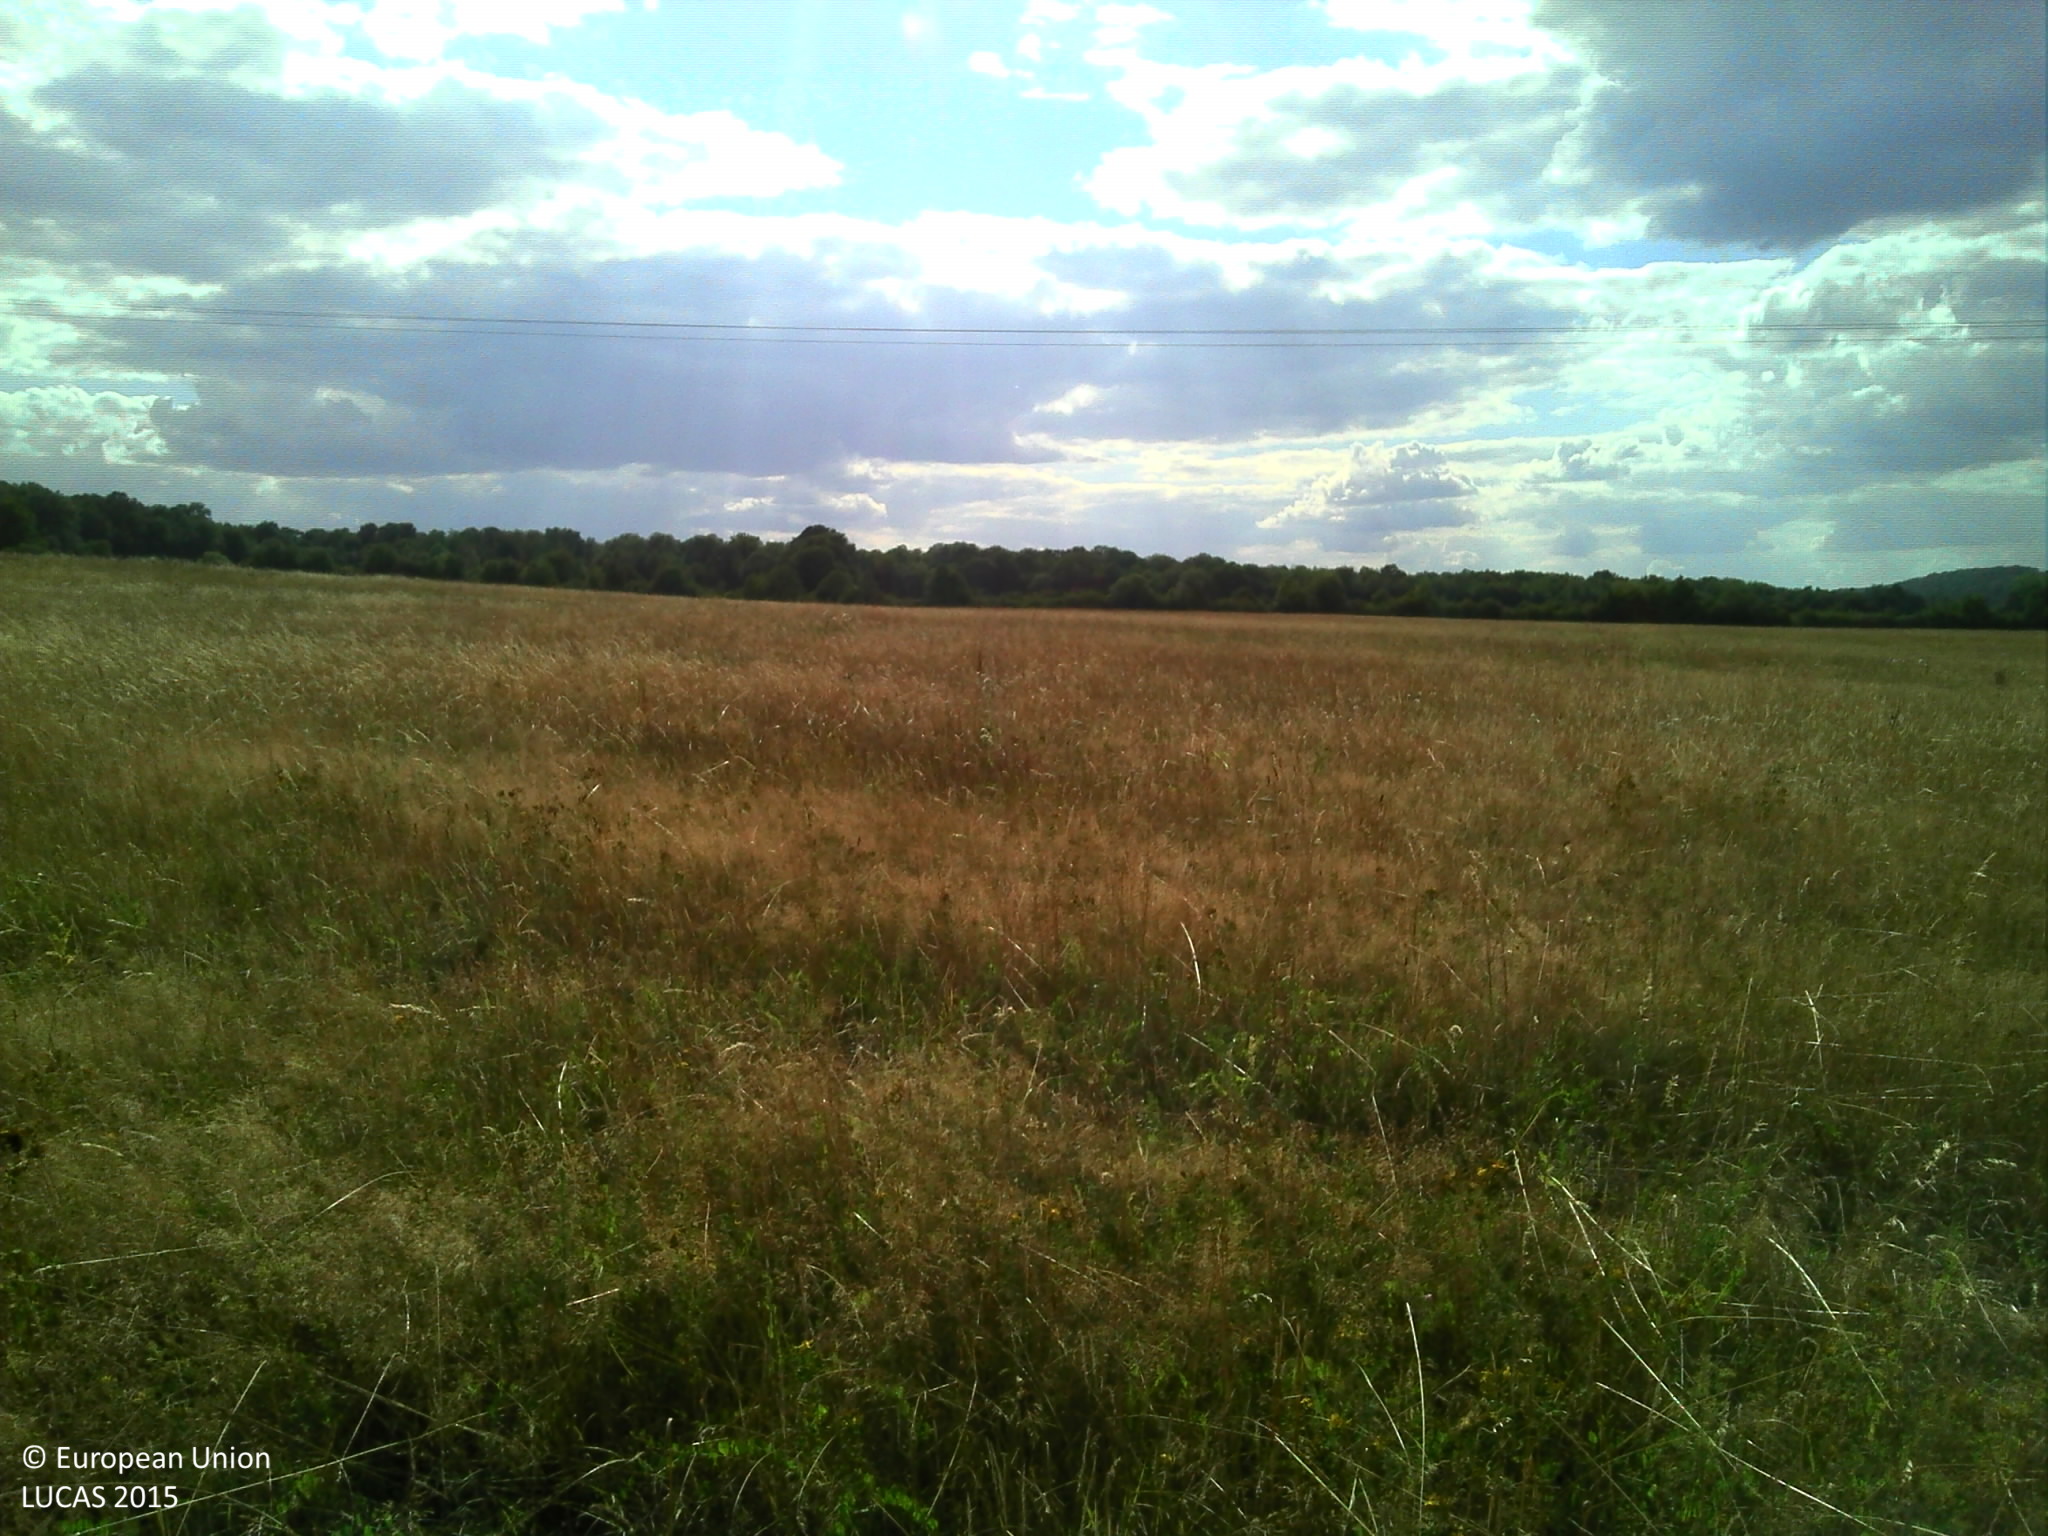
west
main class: Grassland
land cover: Grassland without tree/shrub cover
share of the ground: > 75 %
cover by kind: herbaceous plants 90 %, lichens and mosses 5 %, unconsolidated bare surface 5 %
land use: Agriculture (excluding fallow land and kitchen gardens)
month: July
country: FR
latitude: 48.9487
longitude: 3.7541
